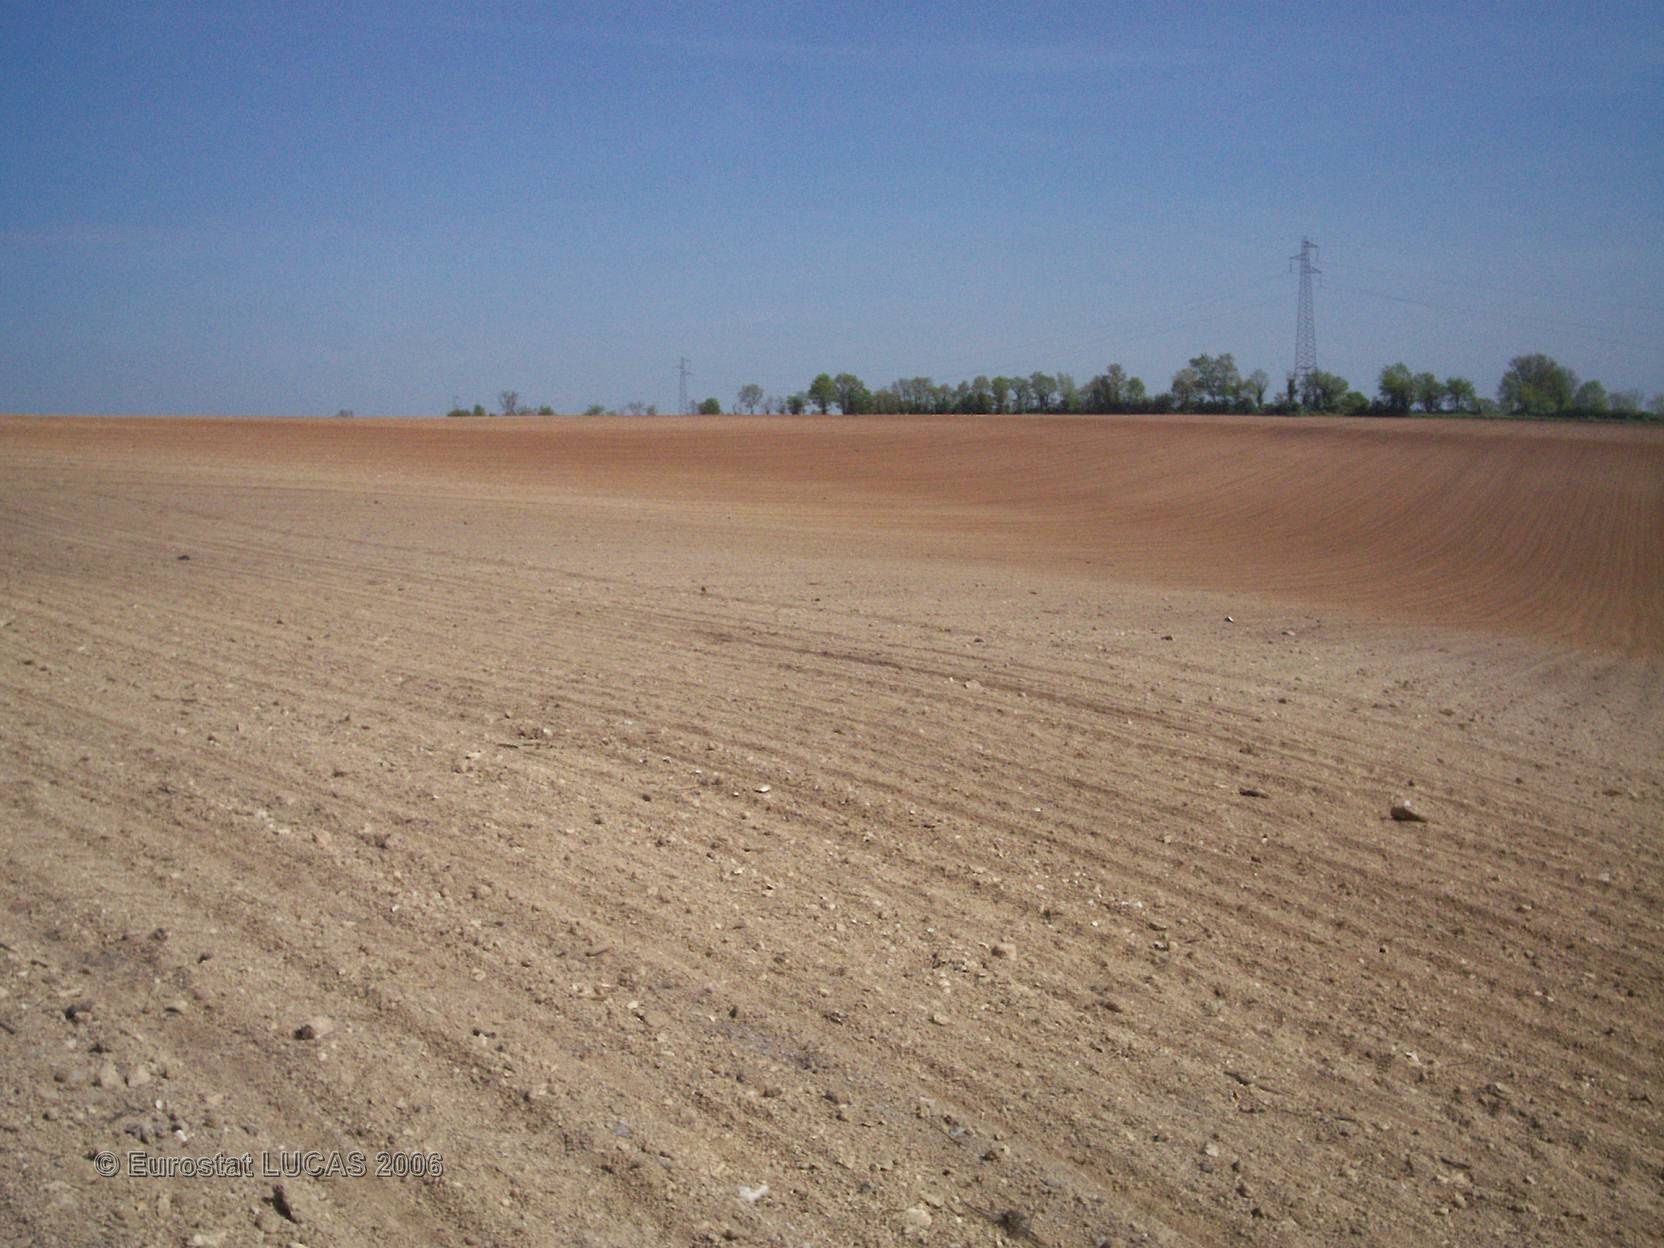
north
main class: Cropland
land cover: Sunflower
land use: Agriculture (excluding fallow land and kitchen gardens)
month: May
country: FR
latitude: 46.2026
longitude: -0.2479
